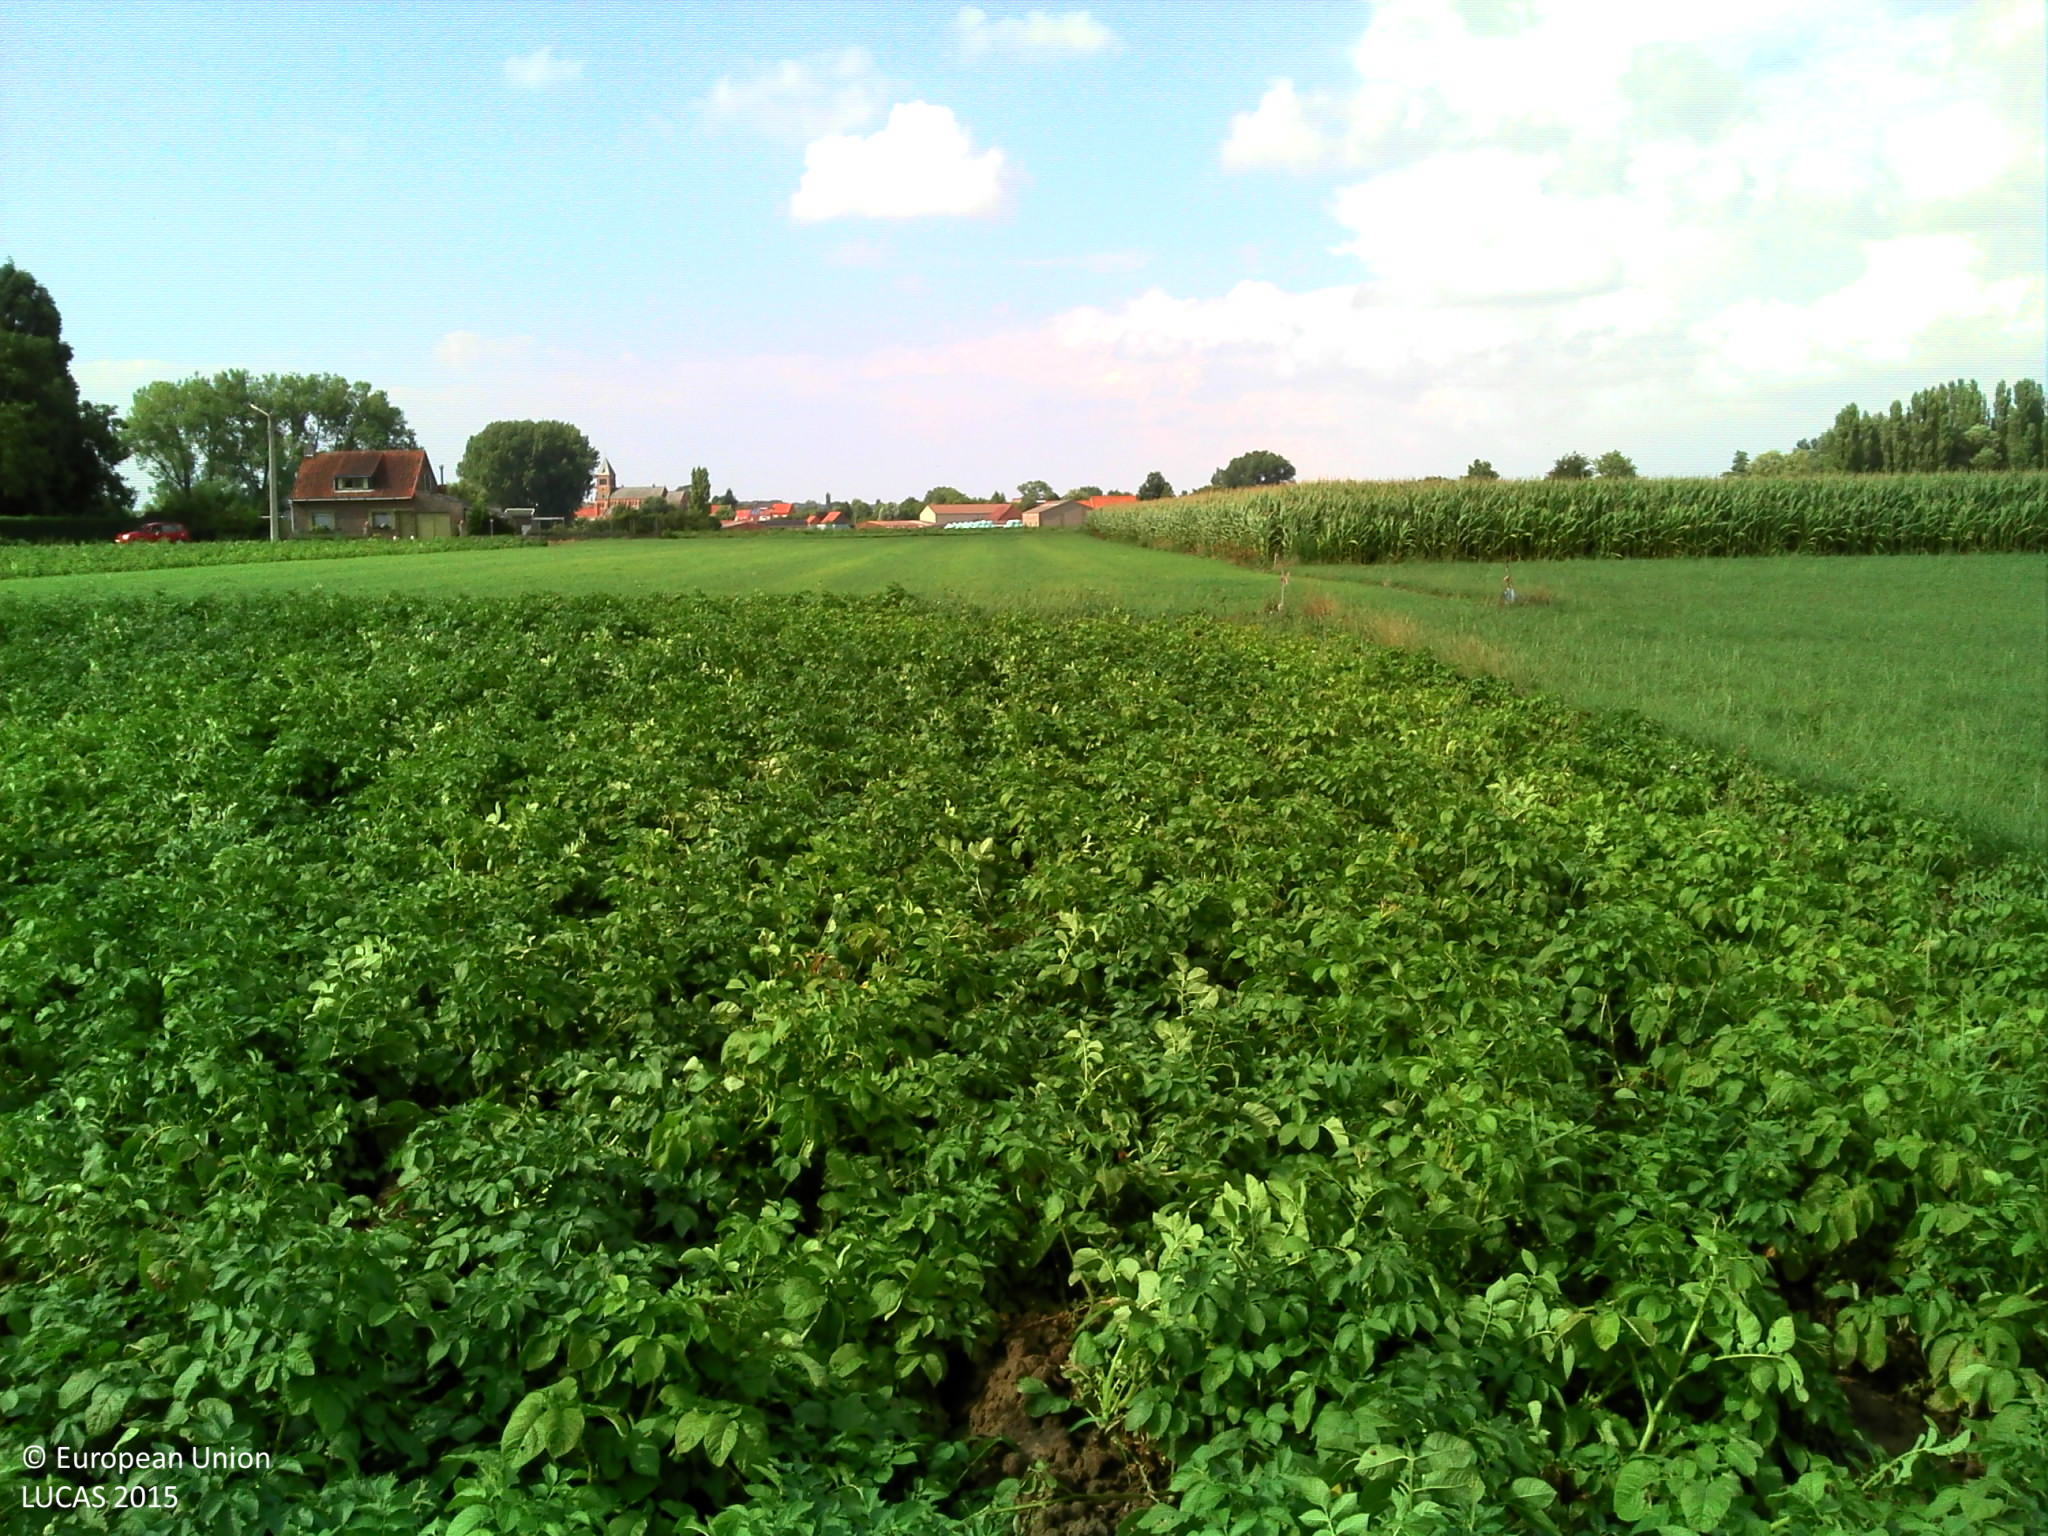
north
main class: Cropland
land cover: Potatoes
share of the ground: > 75 %
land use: Agriculture (excluding fallow land and kitchen gardens)
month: August
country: BE
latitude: 50.7794
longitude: 2.9695
